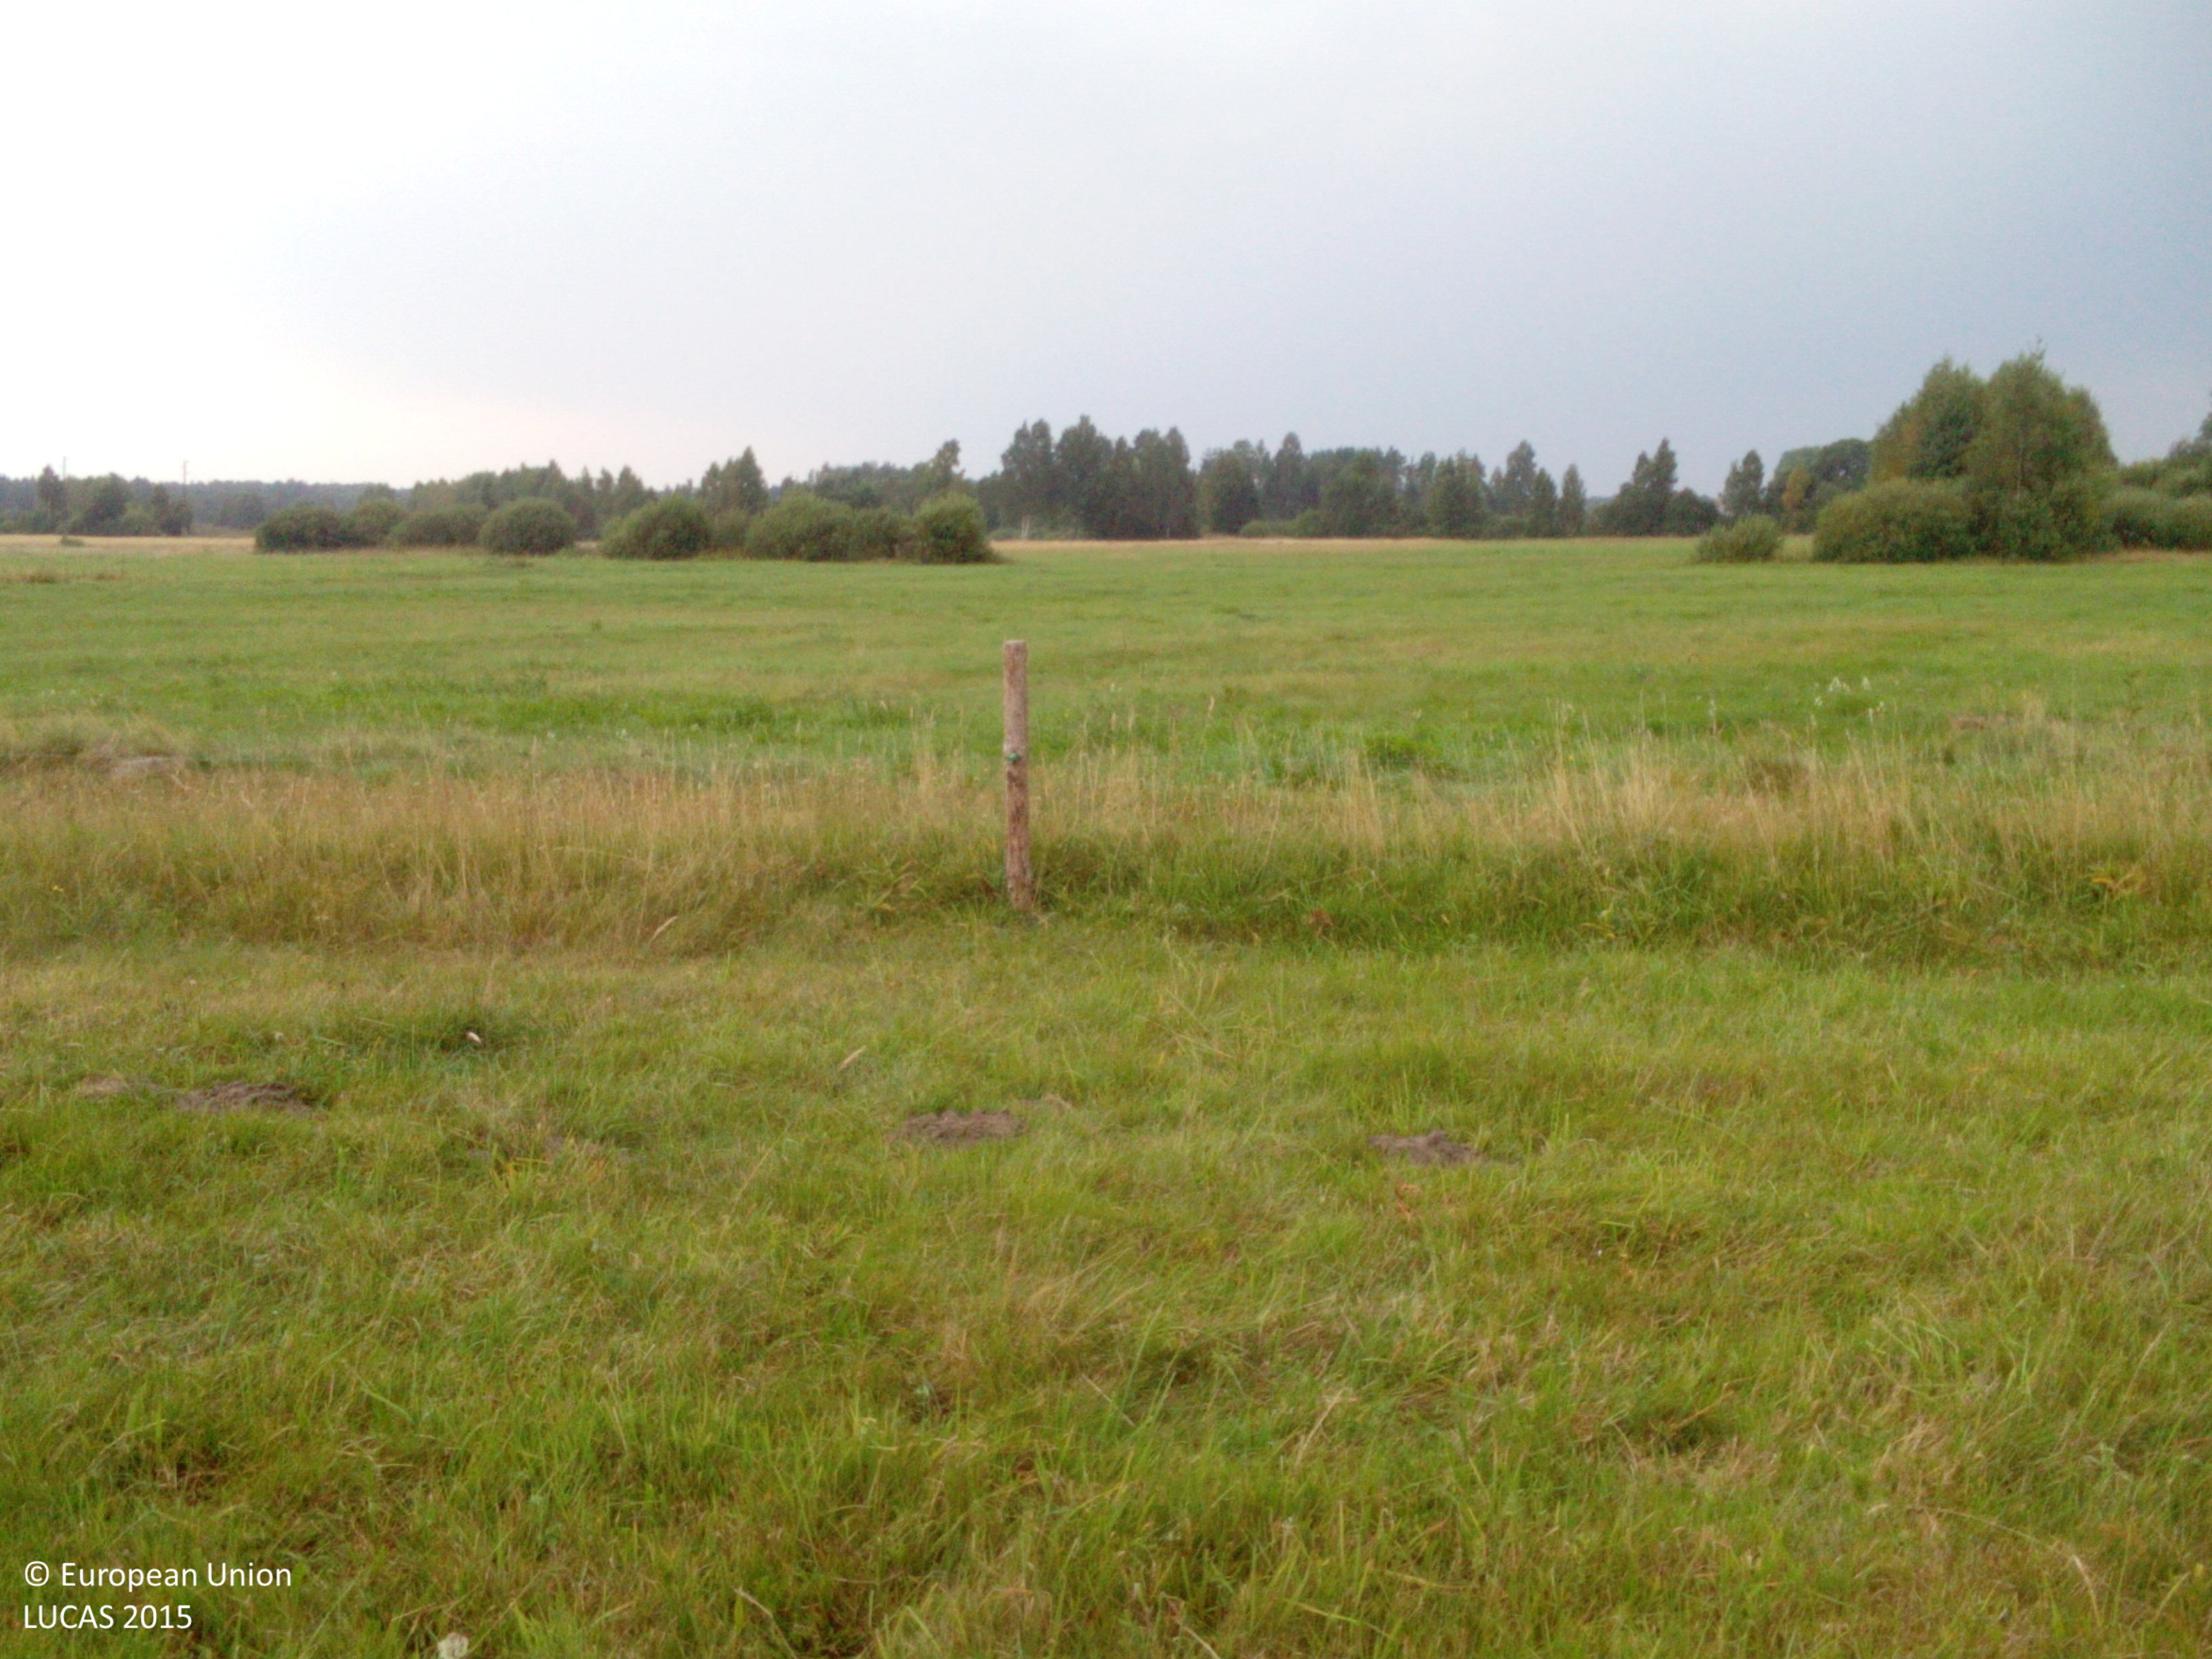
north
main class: Grassland
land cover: Grassland without tree/shrub cover
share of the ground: > 75 %
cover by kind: herbaceous plants 100 %
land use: Agriculture (excluding fallow land and kitchen gardens)
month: August
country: LV
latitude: 56.1710
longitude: 21.1683
